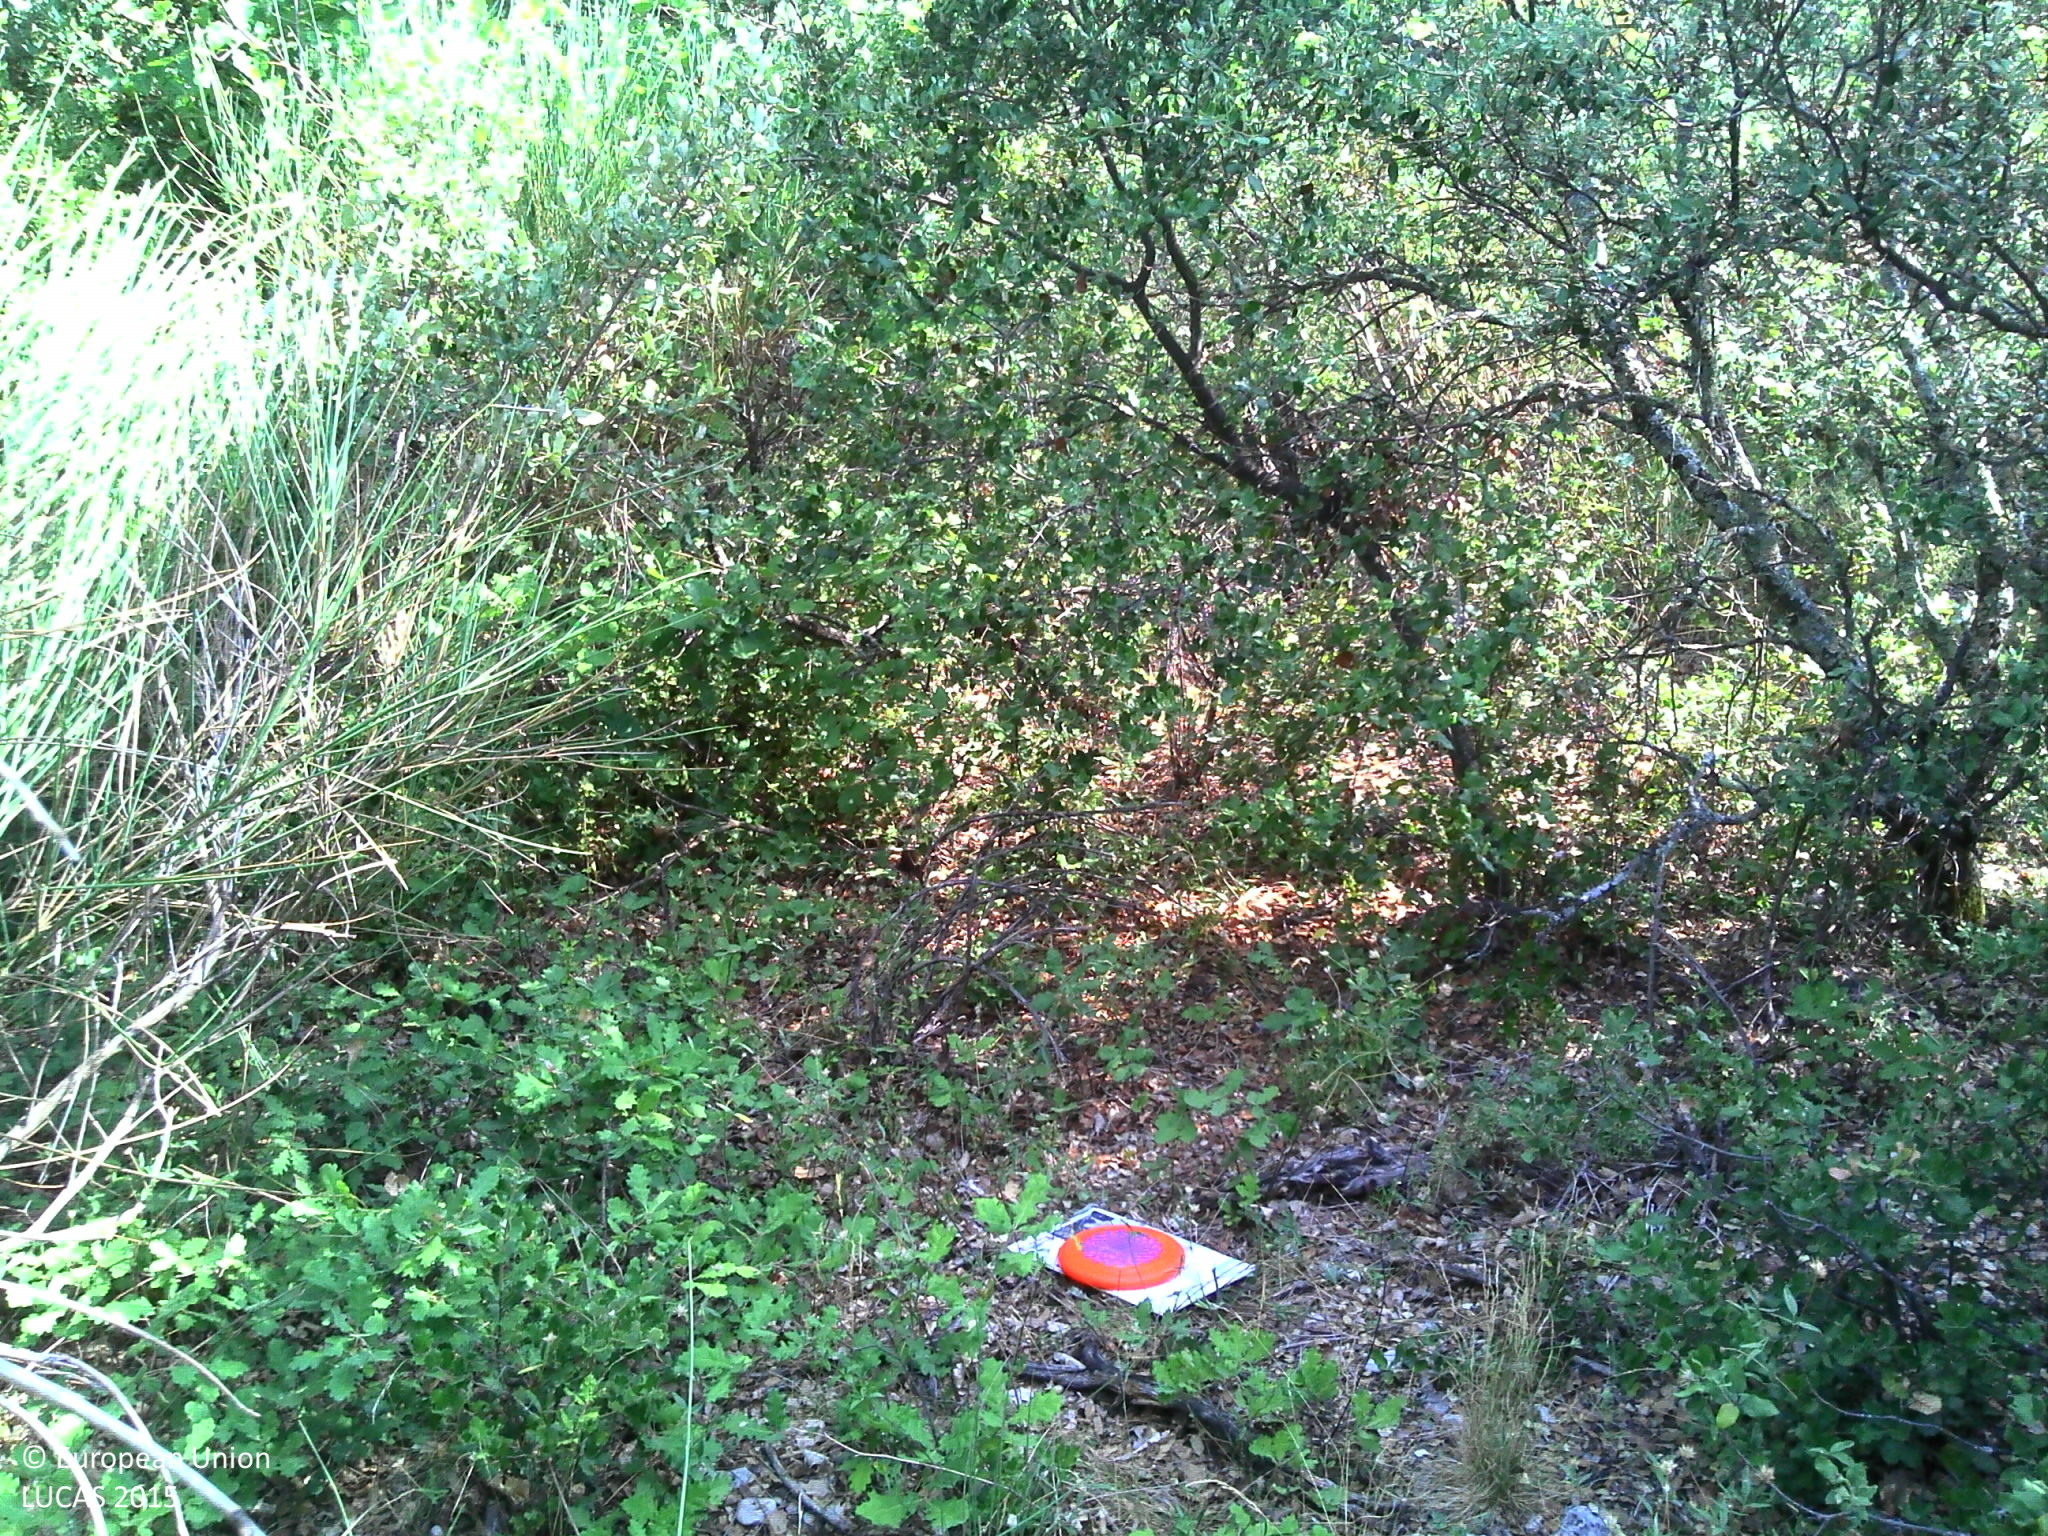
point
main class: Woodland
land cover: Broadleaved woodland
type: thermophilous deciduous forest
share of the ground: > 75 %
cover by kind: broadleaved forest trees 60 %, shrubs 20 %, herbaceous plants 10 %, lichens and mosses 5 %, unconsolidated bare surface 5 %
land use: Semi-natural and natural areas not in use
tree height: < 5 m
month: July
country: FR
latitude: 44.1141
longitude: 5.2226
